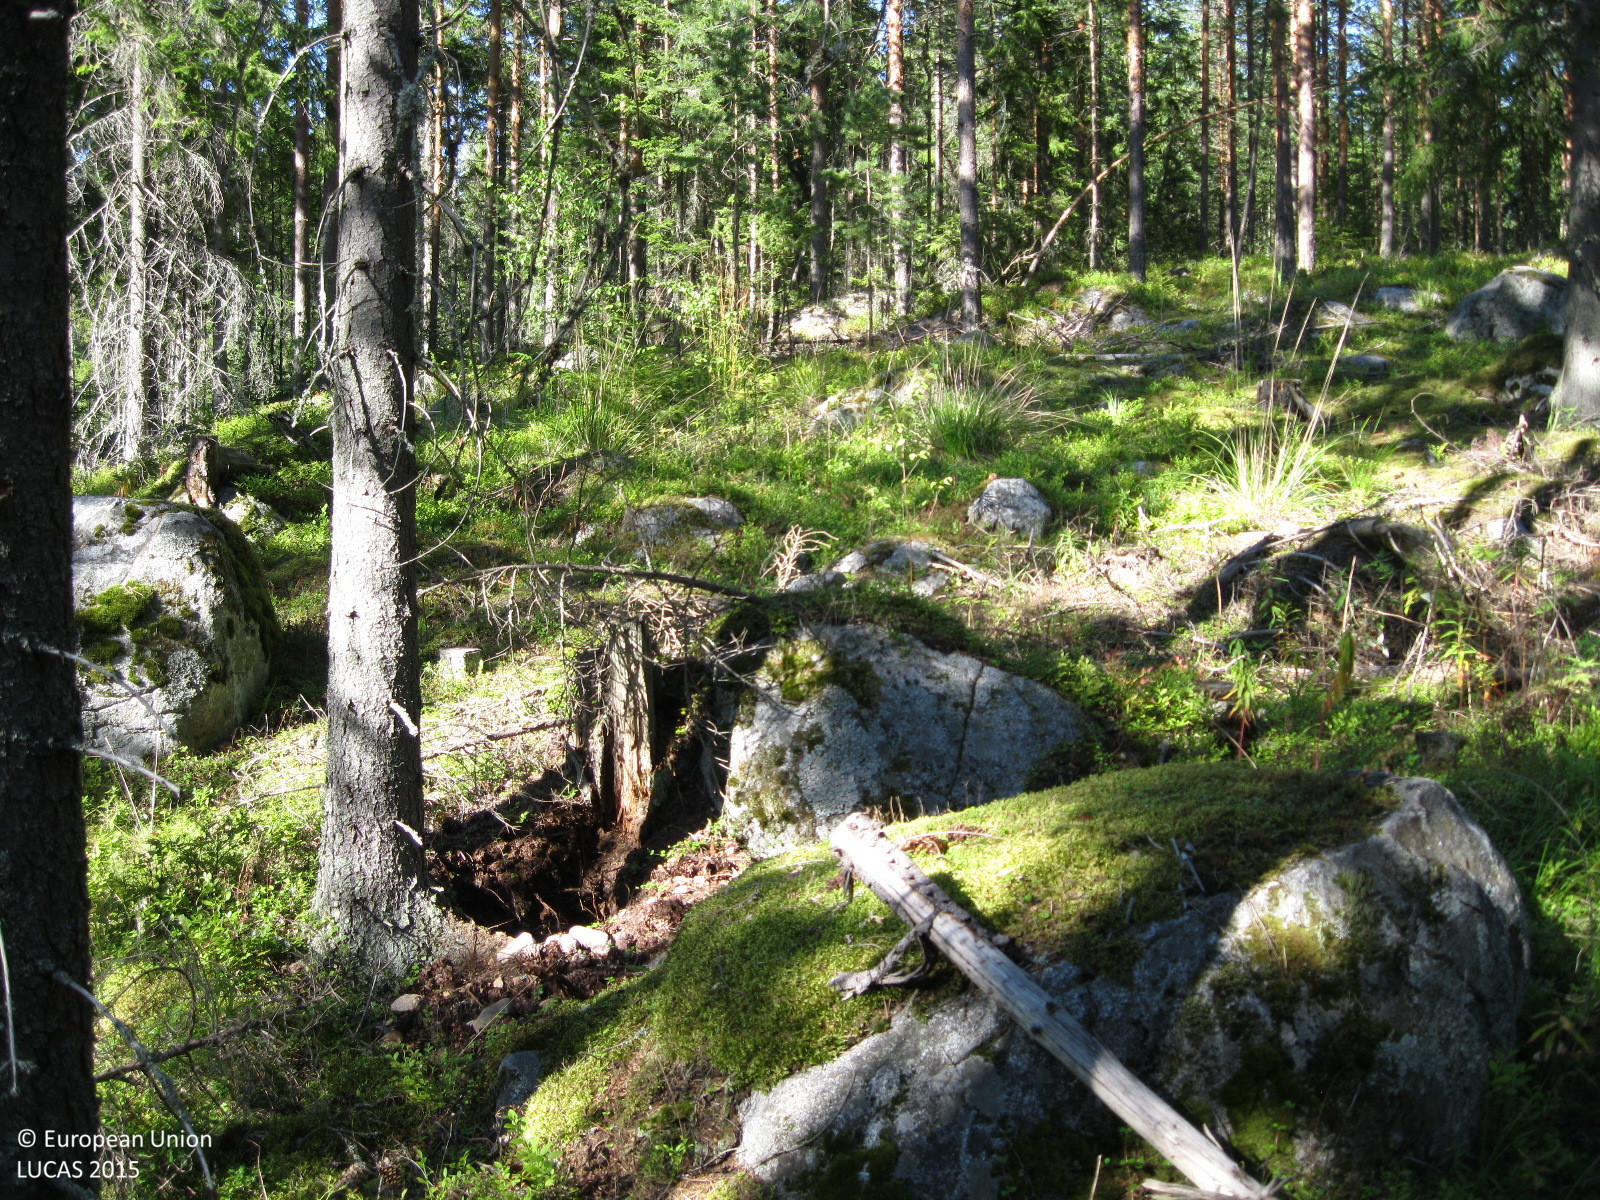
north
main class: Woodland
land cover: Spruce dominated coniferous woodland
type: boreal forest
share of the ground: > 75 %
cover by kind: coniferous forest trees 75 %, lichens and mosses 15 %, shrubs 5 %, herbaceous plants 5 %
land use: Forestry
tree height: > 5 m
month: August
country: FI
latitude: 61.4264
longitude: 25.3944
